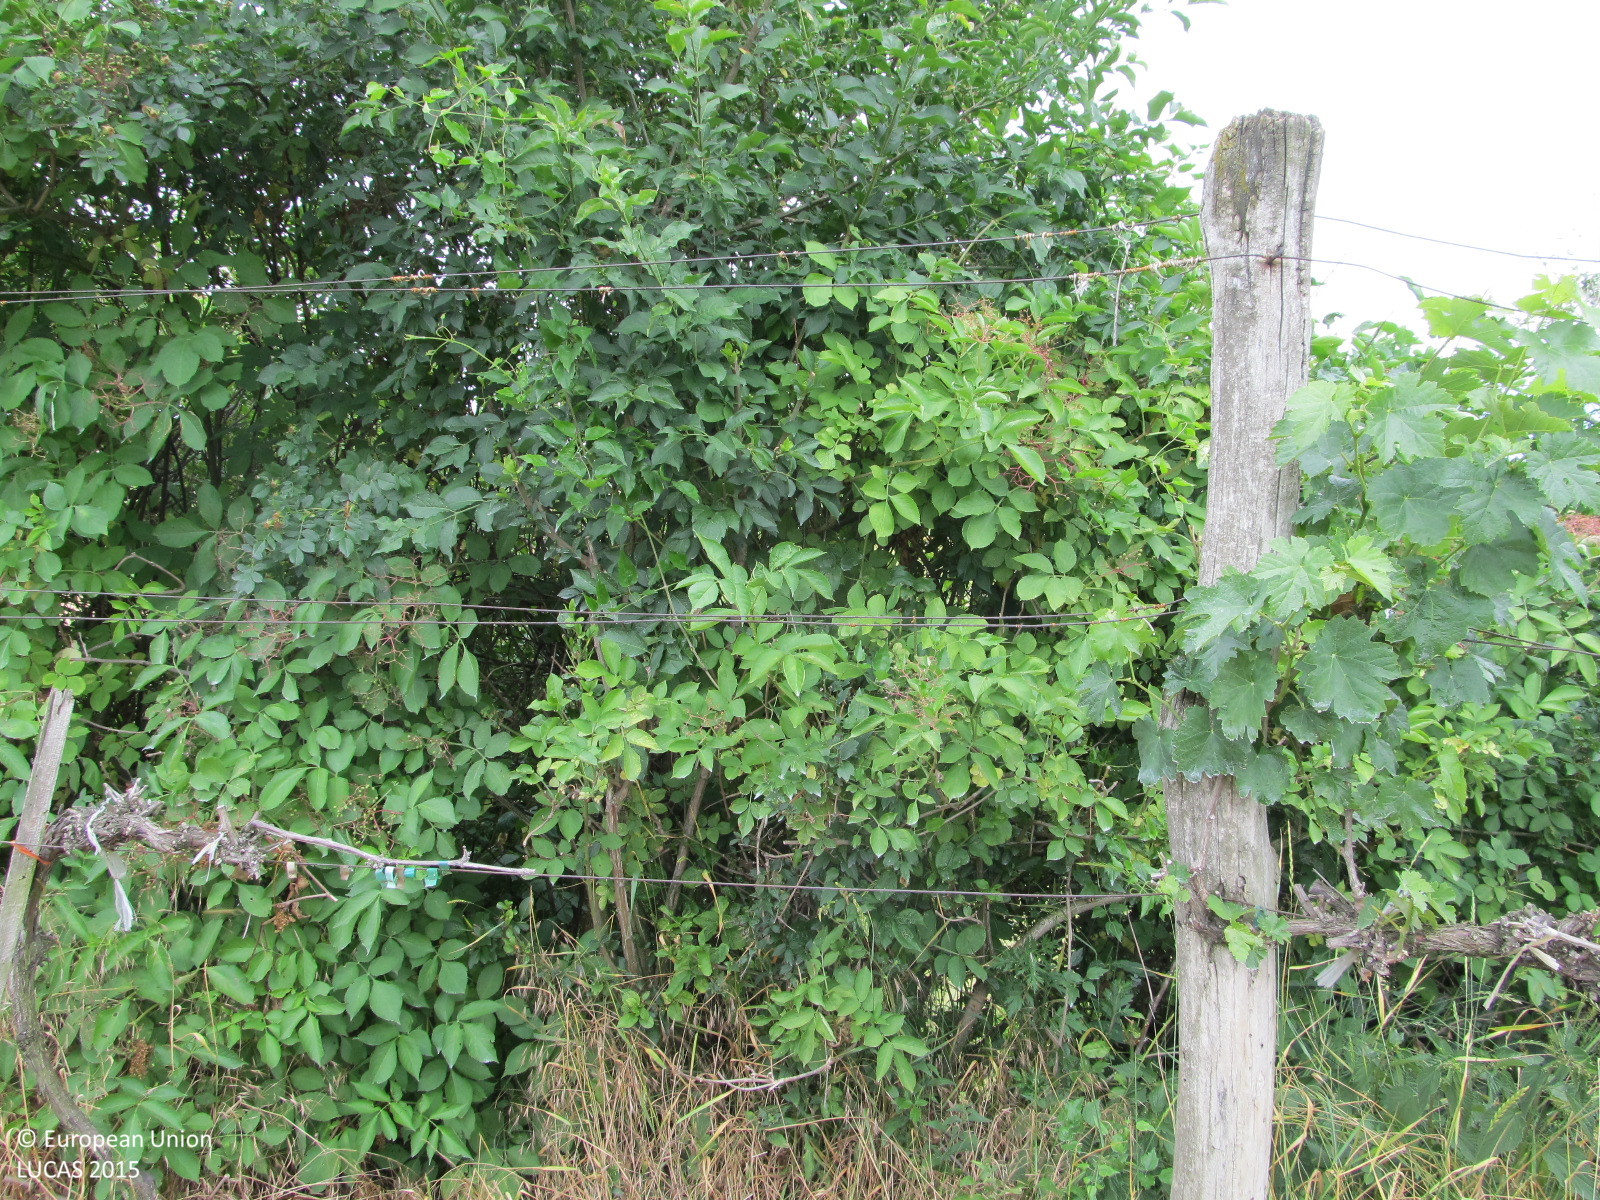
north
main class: Cropland
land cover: Vineyards
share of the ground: 25 - 50 %
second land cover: Grassland without tree/shrub cover
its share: 50 - 75 %
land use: Agriculture (excluding fallow land and kitchen gardens)
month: June
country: AT
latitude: 48.6814
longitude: 16.1851
